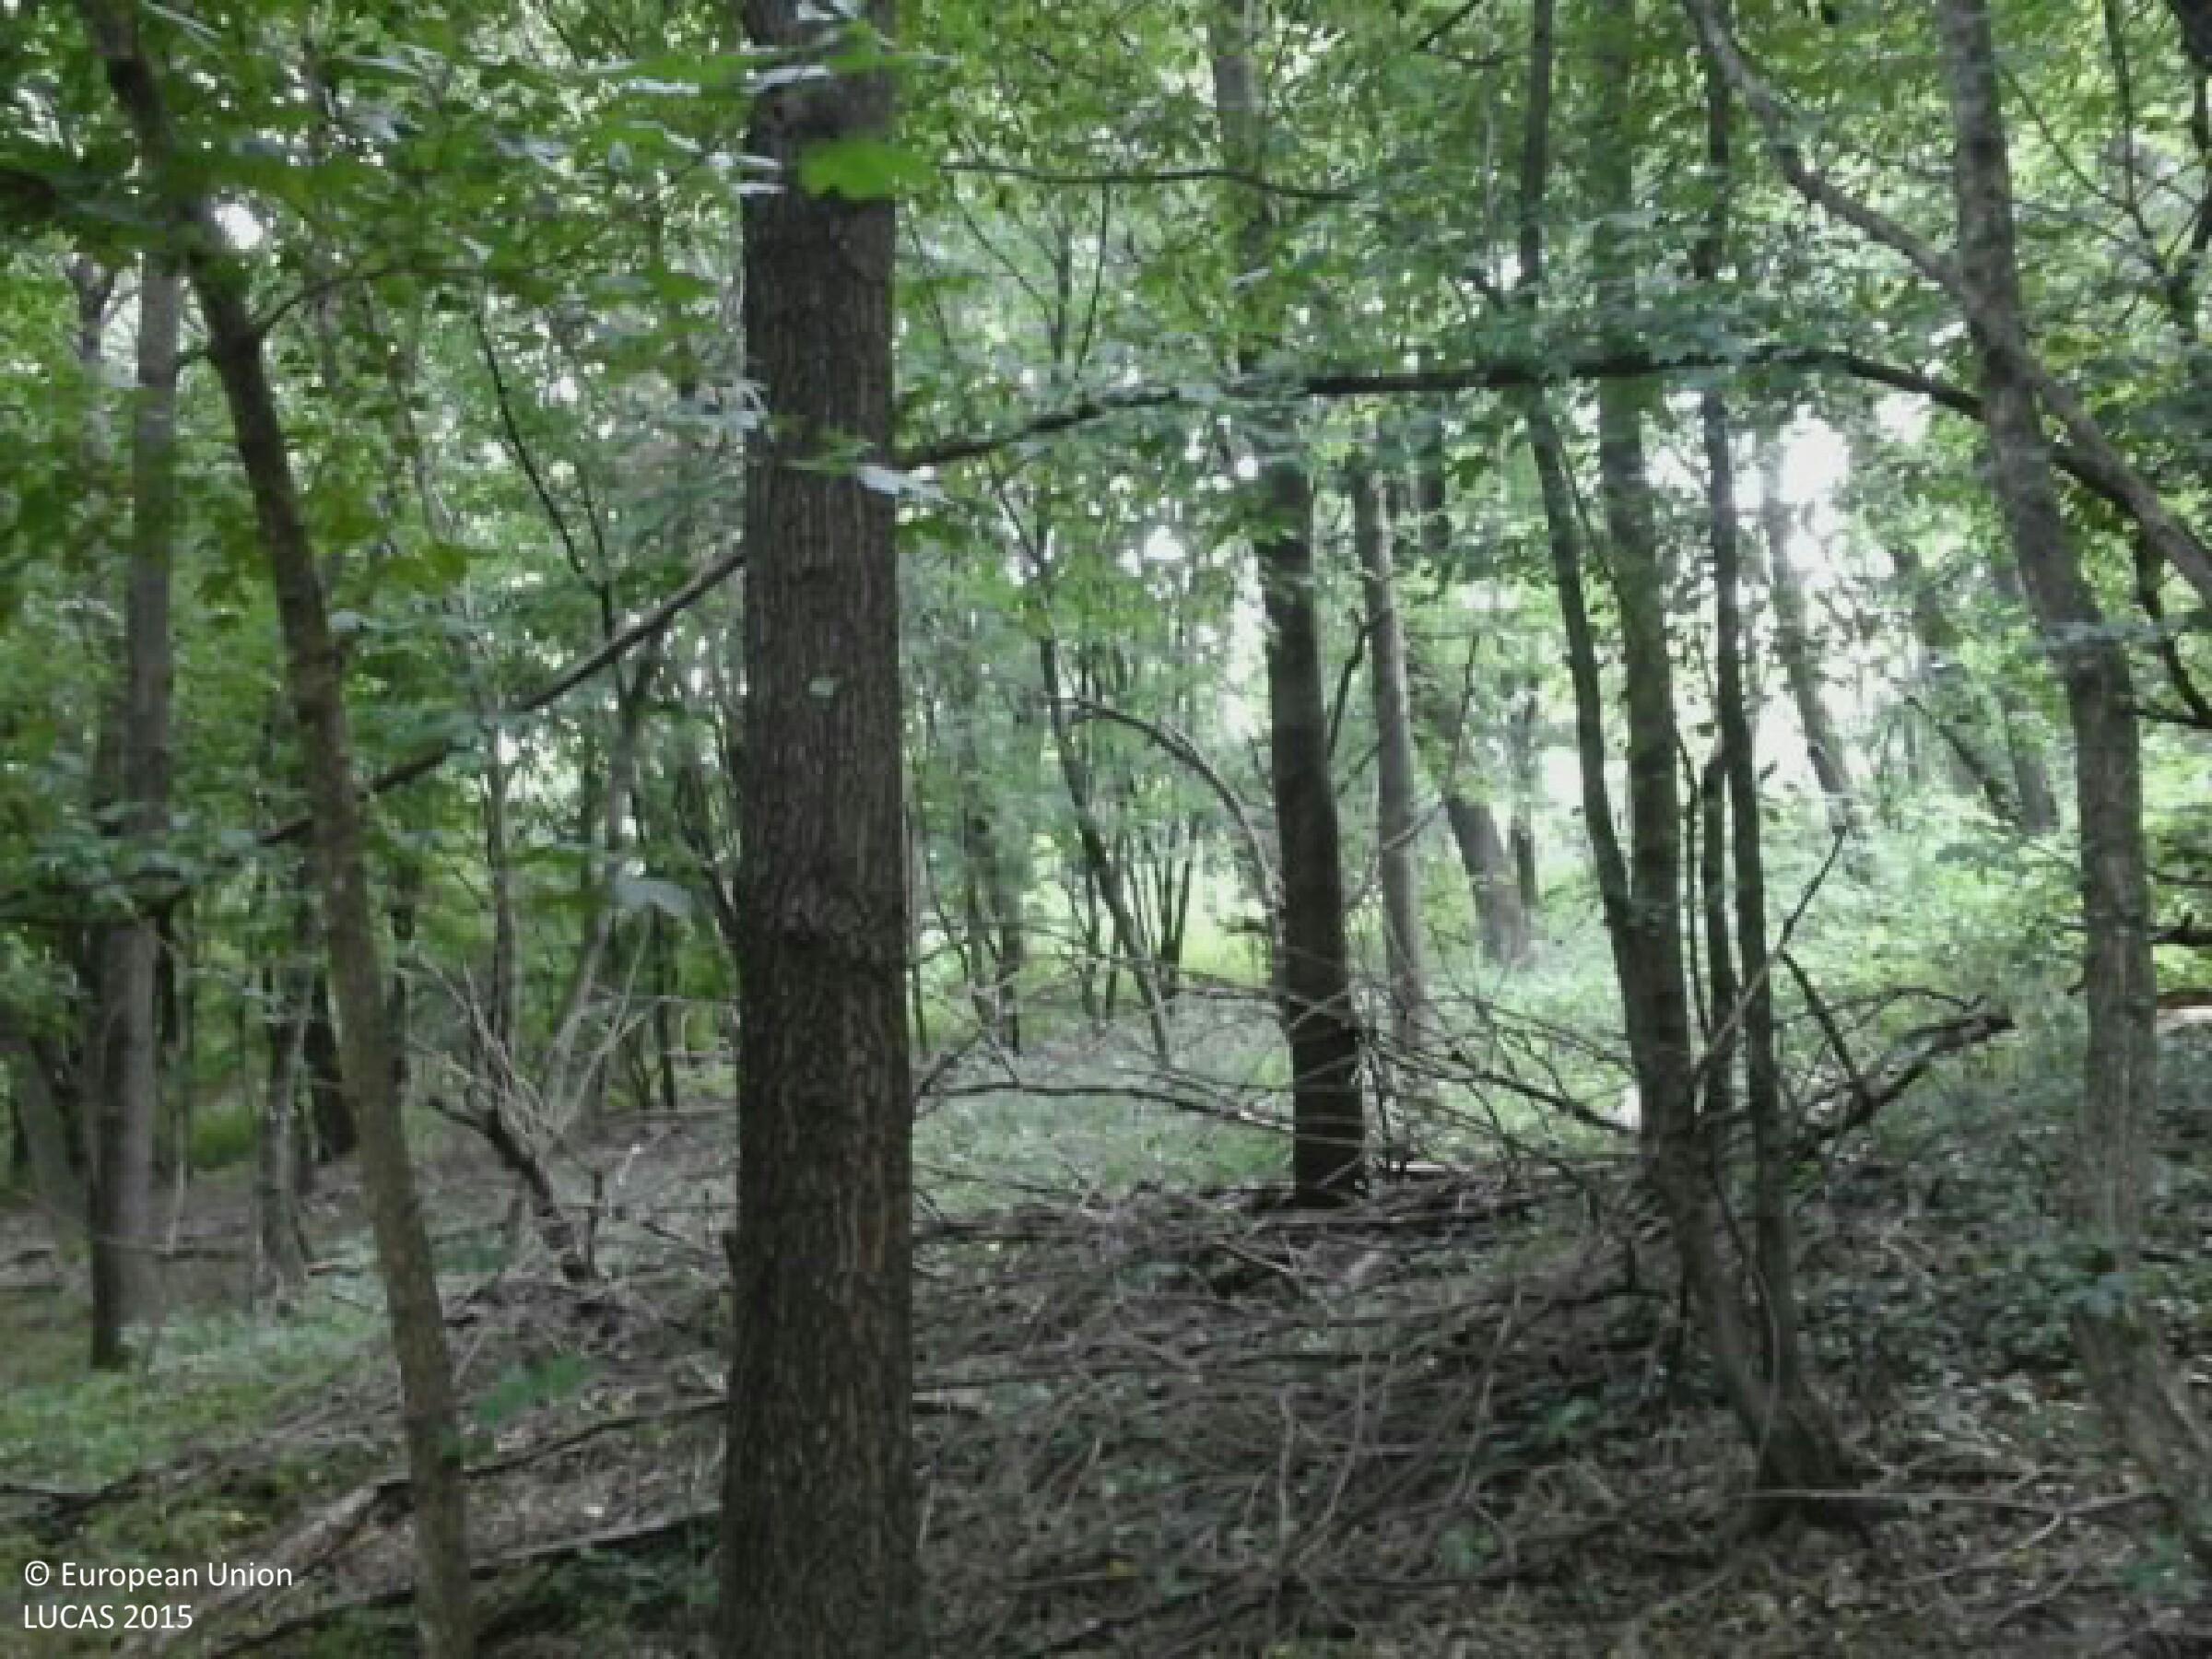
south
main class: Woodland
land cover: Broadleaved woodland
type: mesophytic deciduous forest
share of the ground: > 75 %
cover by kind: broadleaved forest trees 90 %, shrubs 10 %
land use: Forestry
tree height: > 5 m
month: August
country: HU
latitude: 46.4752
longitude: 17.3892
